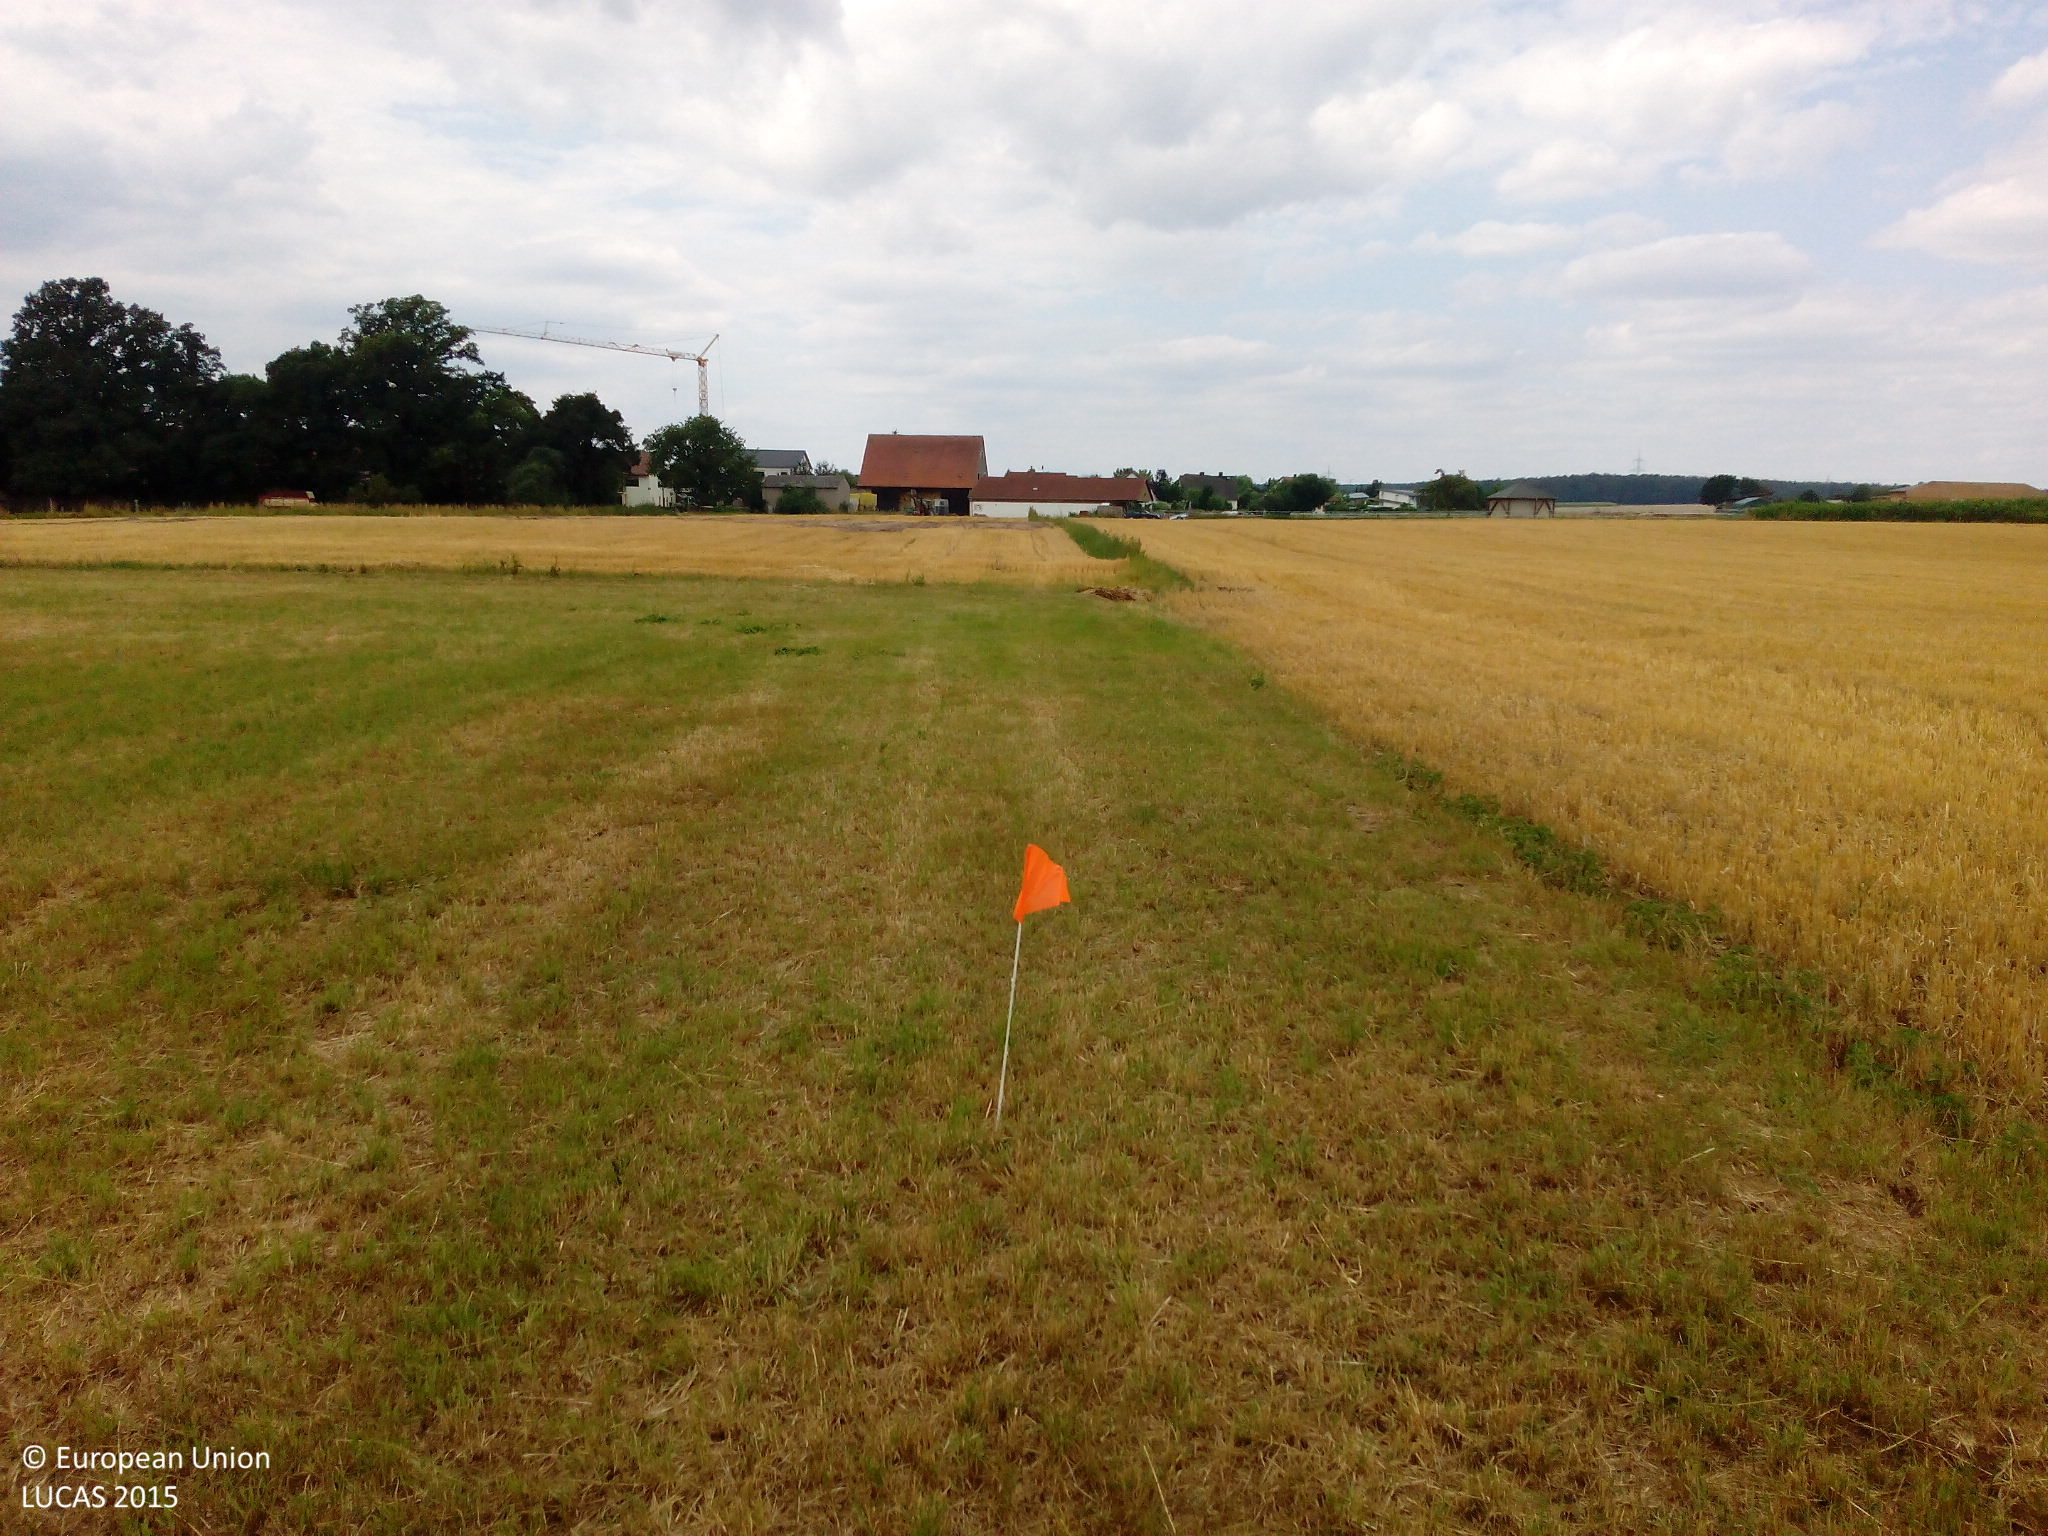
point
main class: Grassland
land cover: Grassland without tree/shrub cover
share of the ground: > 75 %
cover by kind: herbaceous plants 90 %, unconsolidated bare surface 10 %
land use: Agriculture (excluding fallow land and kitchen gardens)
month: July
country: DE
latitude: 49.5330
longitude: 10.9254
